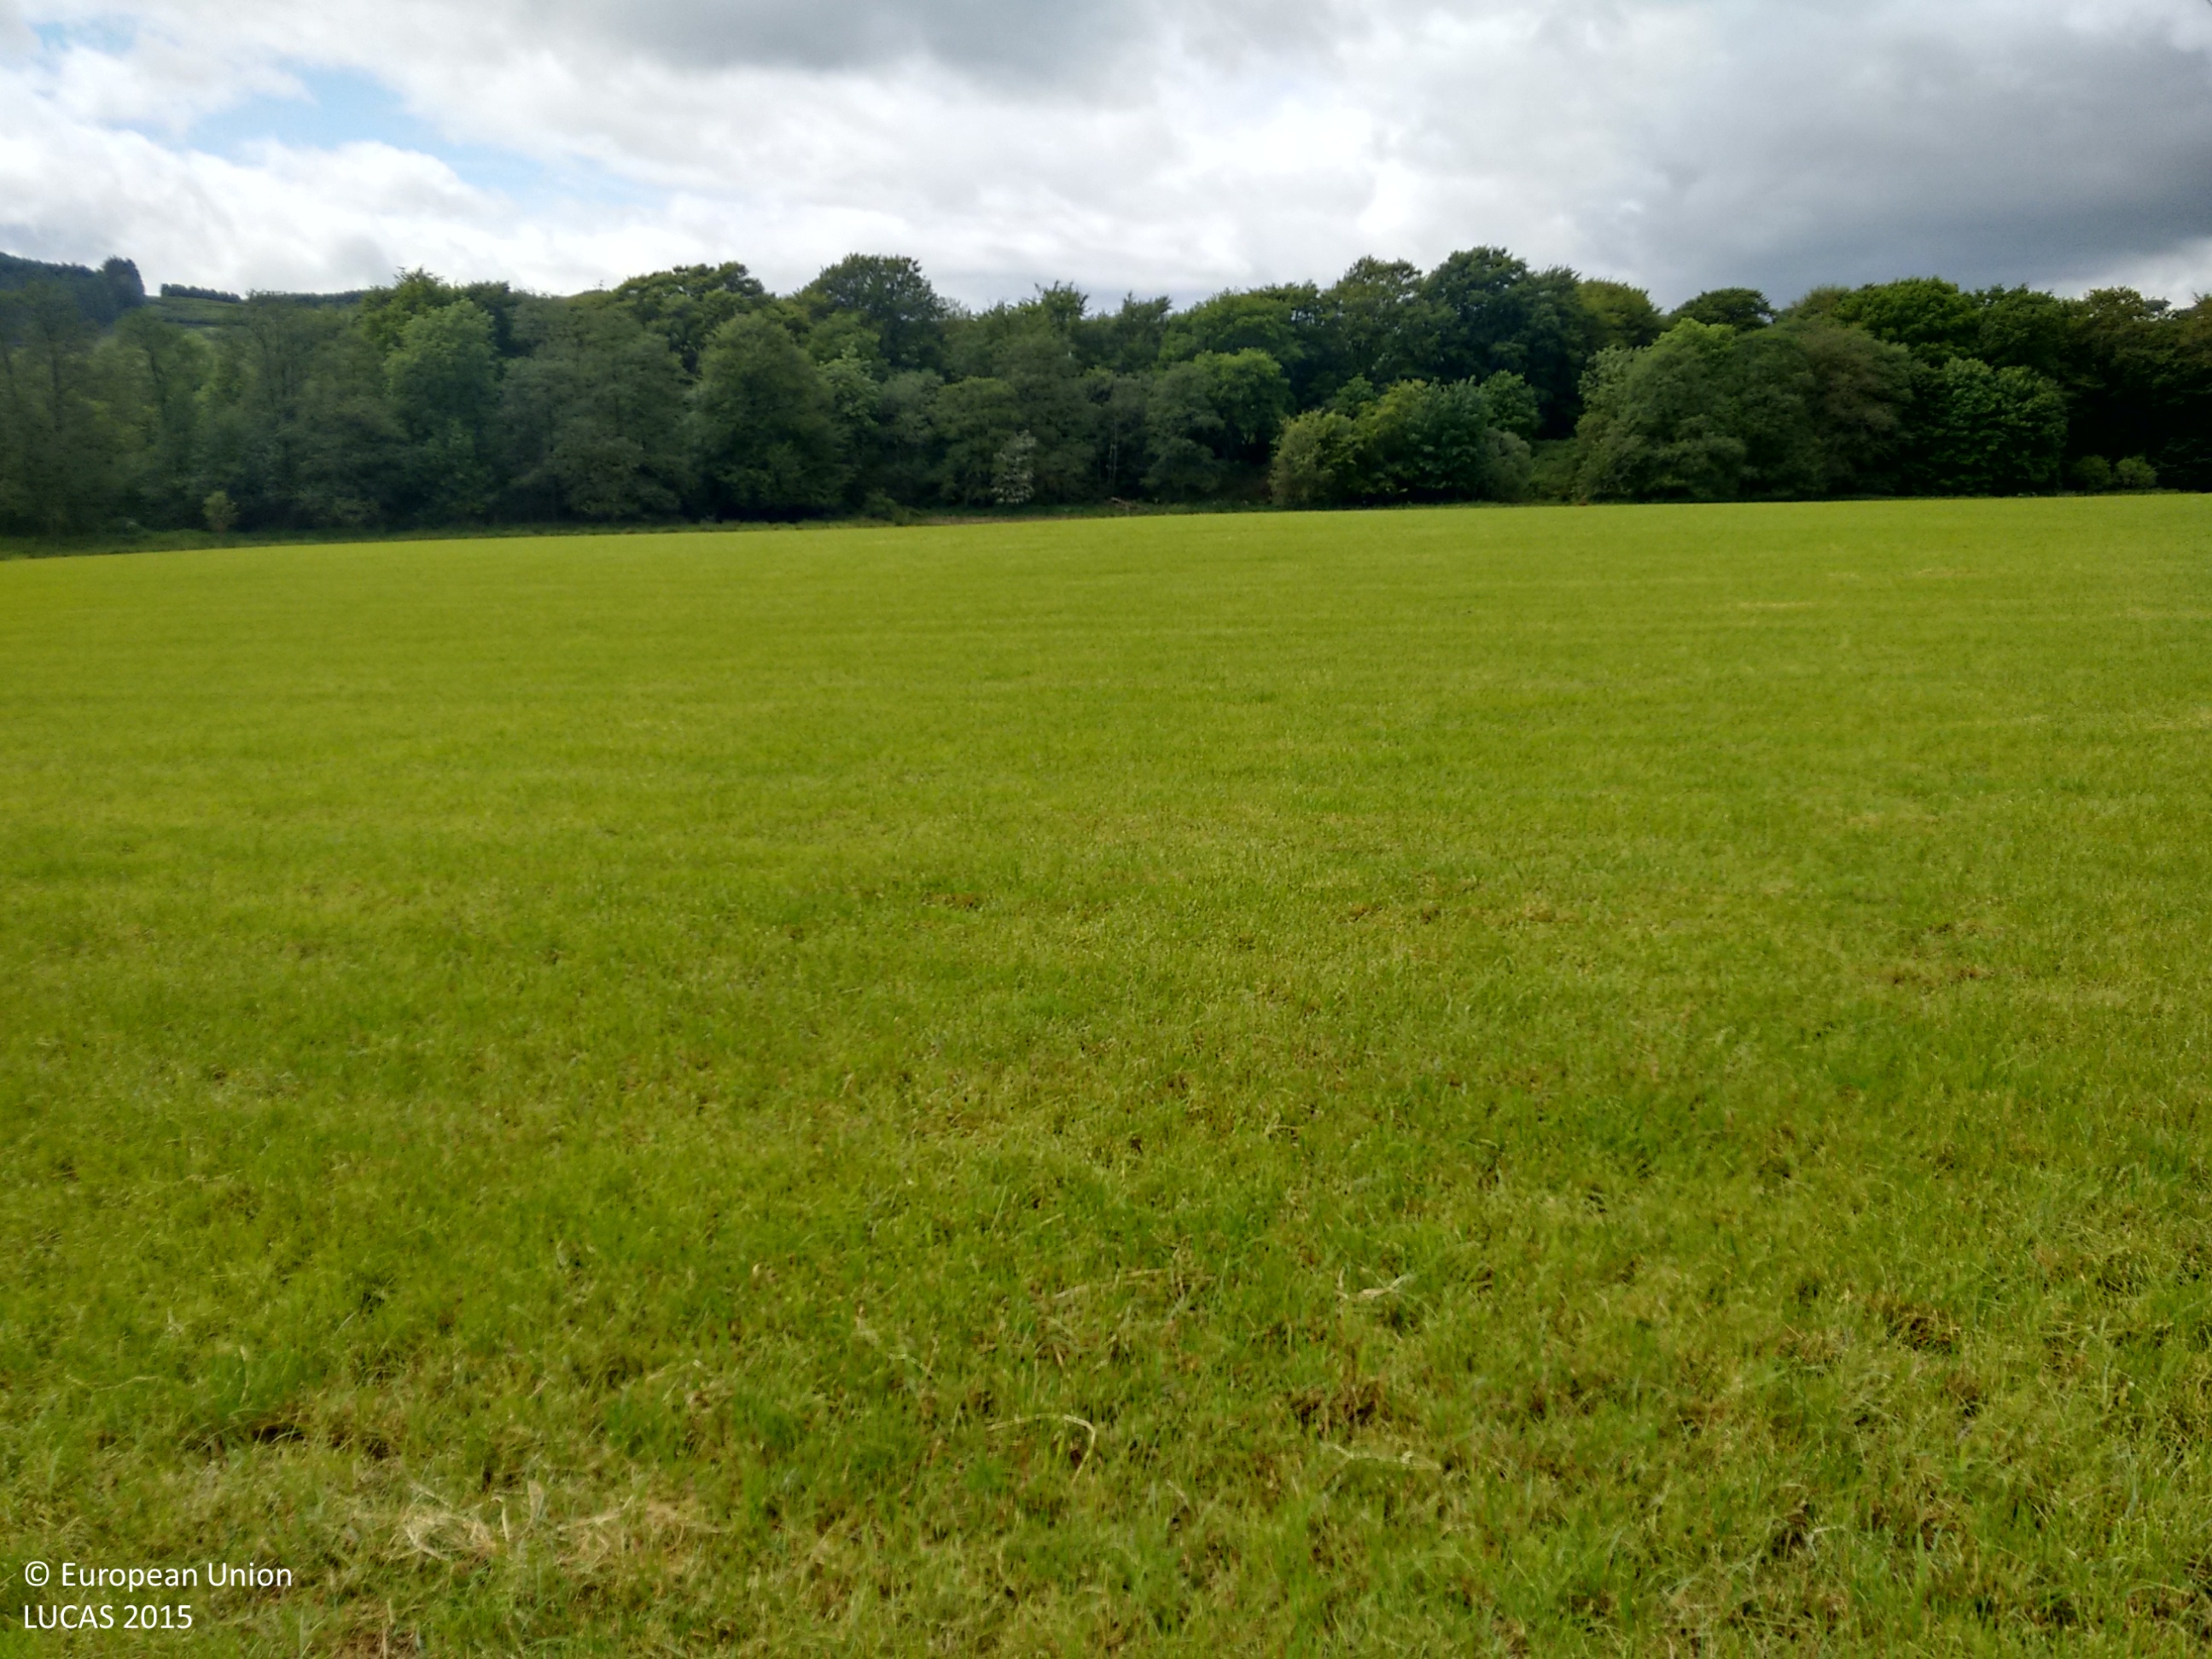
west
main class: Grassland
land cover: Grassland without tree/shrub cover
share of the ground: > 75 %
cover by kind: herbaceous plants 90 %, unconsolidated bare surface 10 %
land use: Agriculture (excluding fallow land and kitchen gardens)
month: June
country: GB
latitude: 55.1101
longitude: -3.4510
